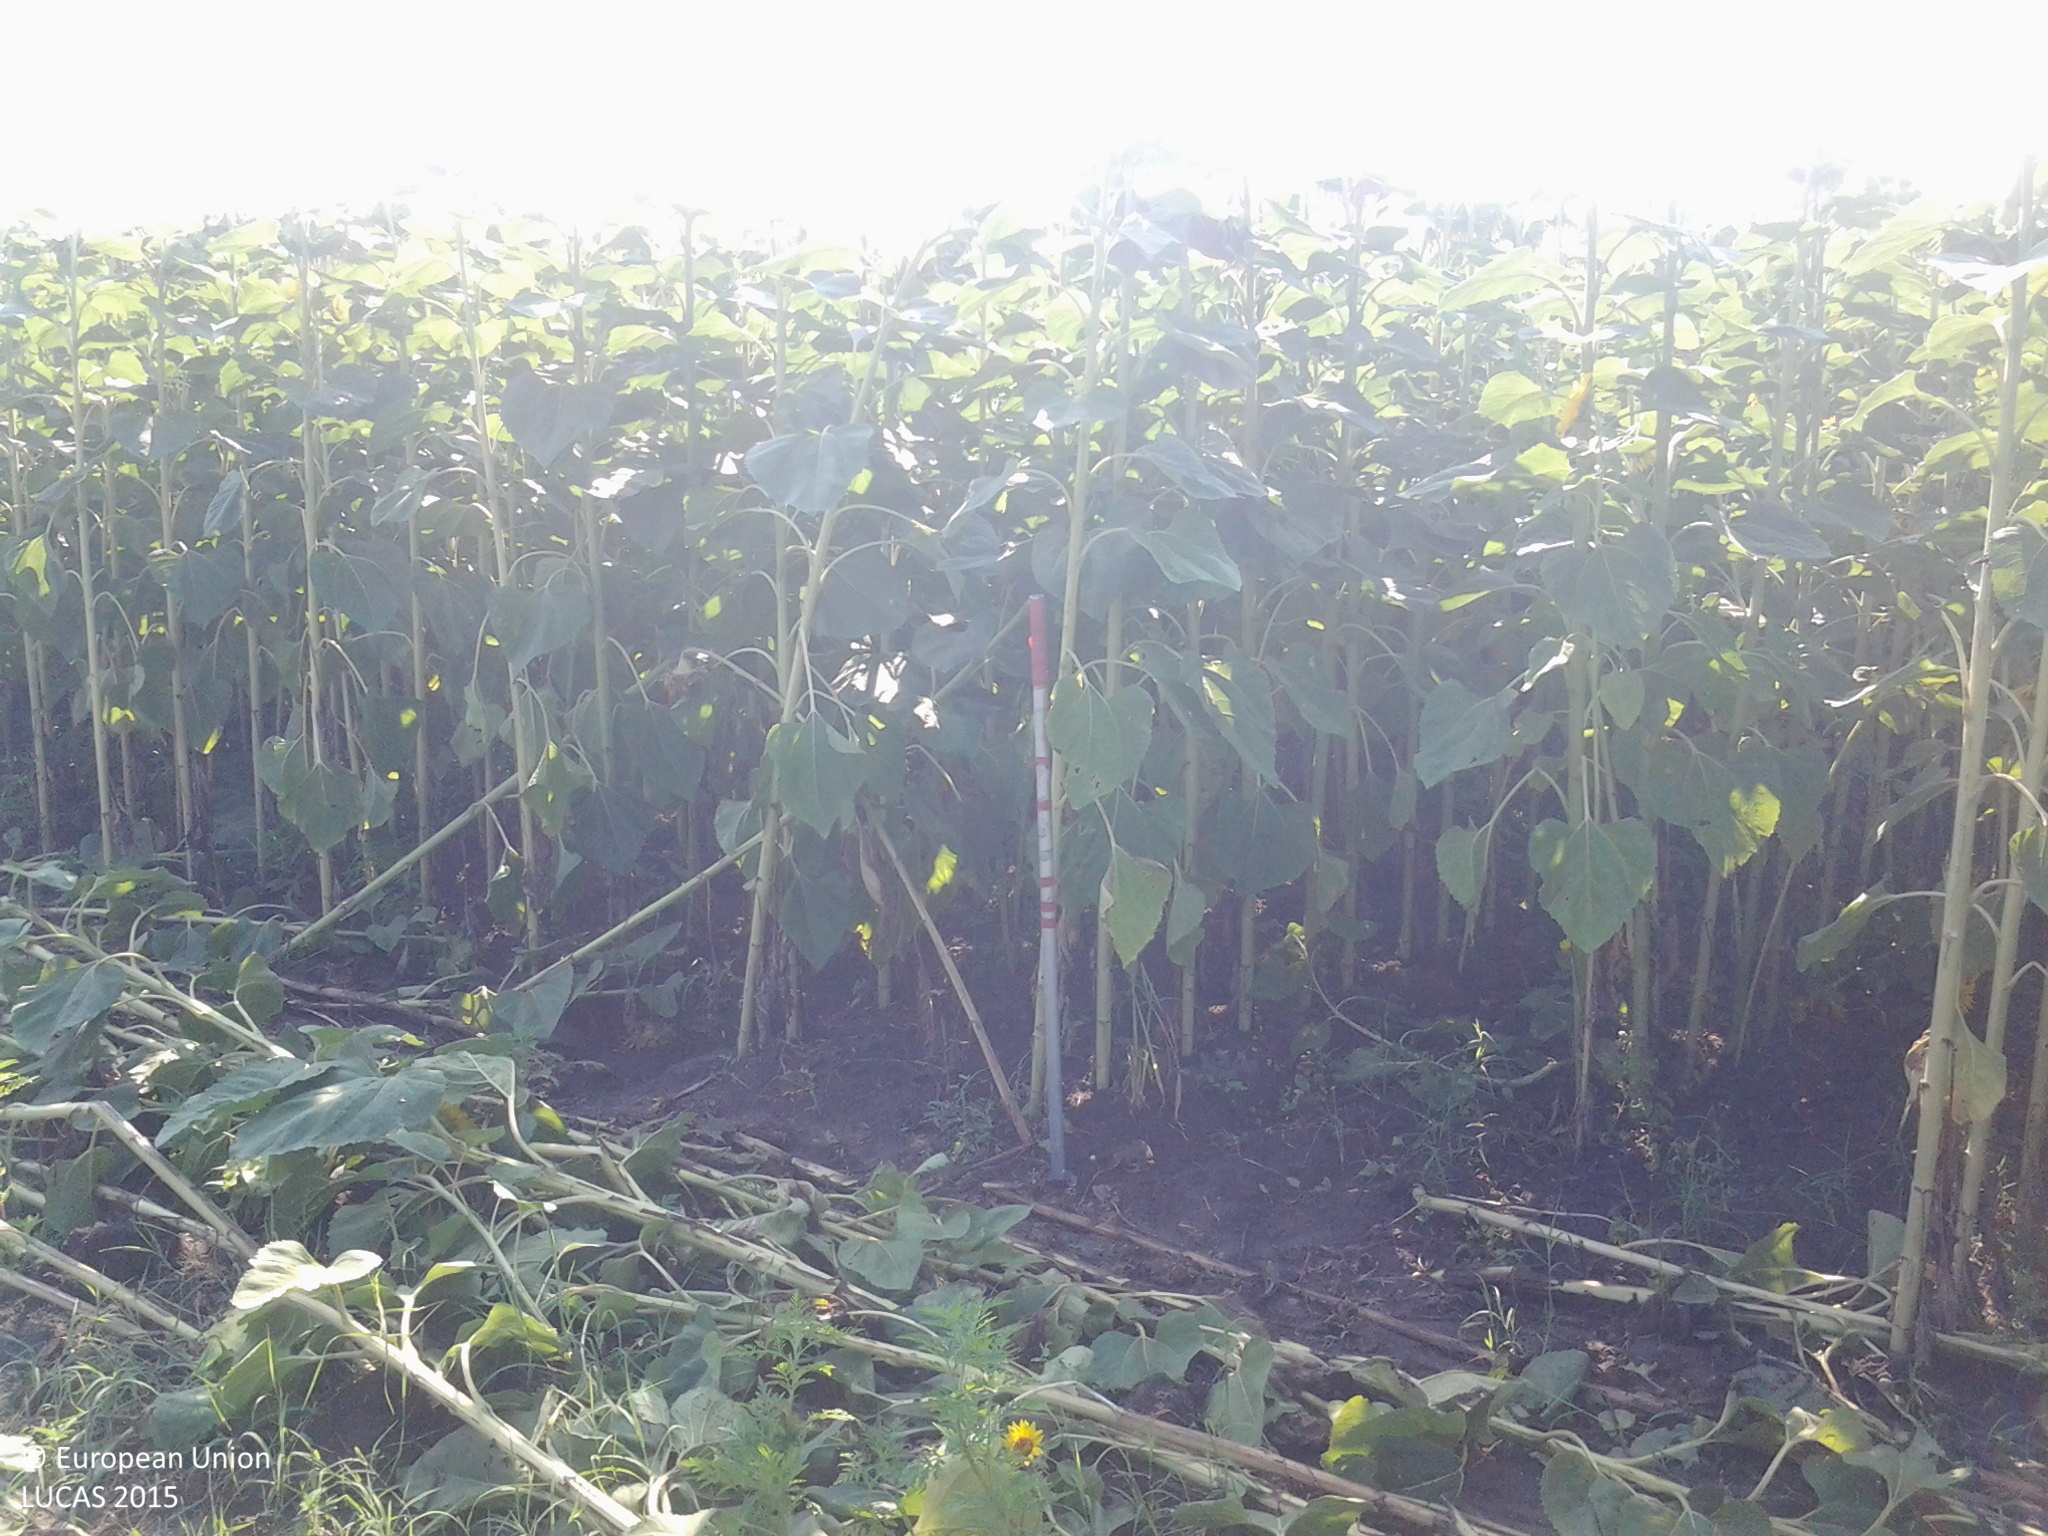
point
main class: Cropland
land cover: Sunflower
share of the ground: > 75 %
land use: Agriculture (excluding fallow land and kitchen gardens)
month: July
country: HU
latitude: 46.8188
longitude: 19.0459
